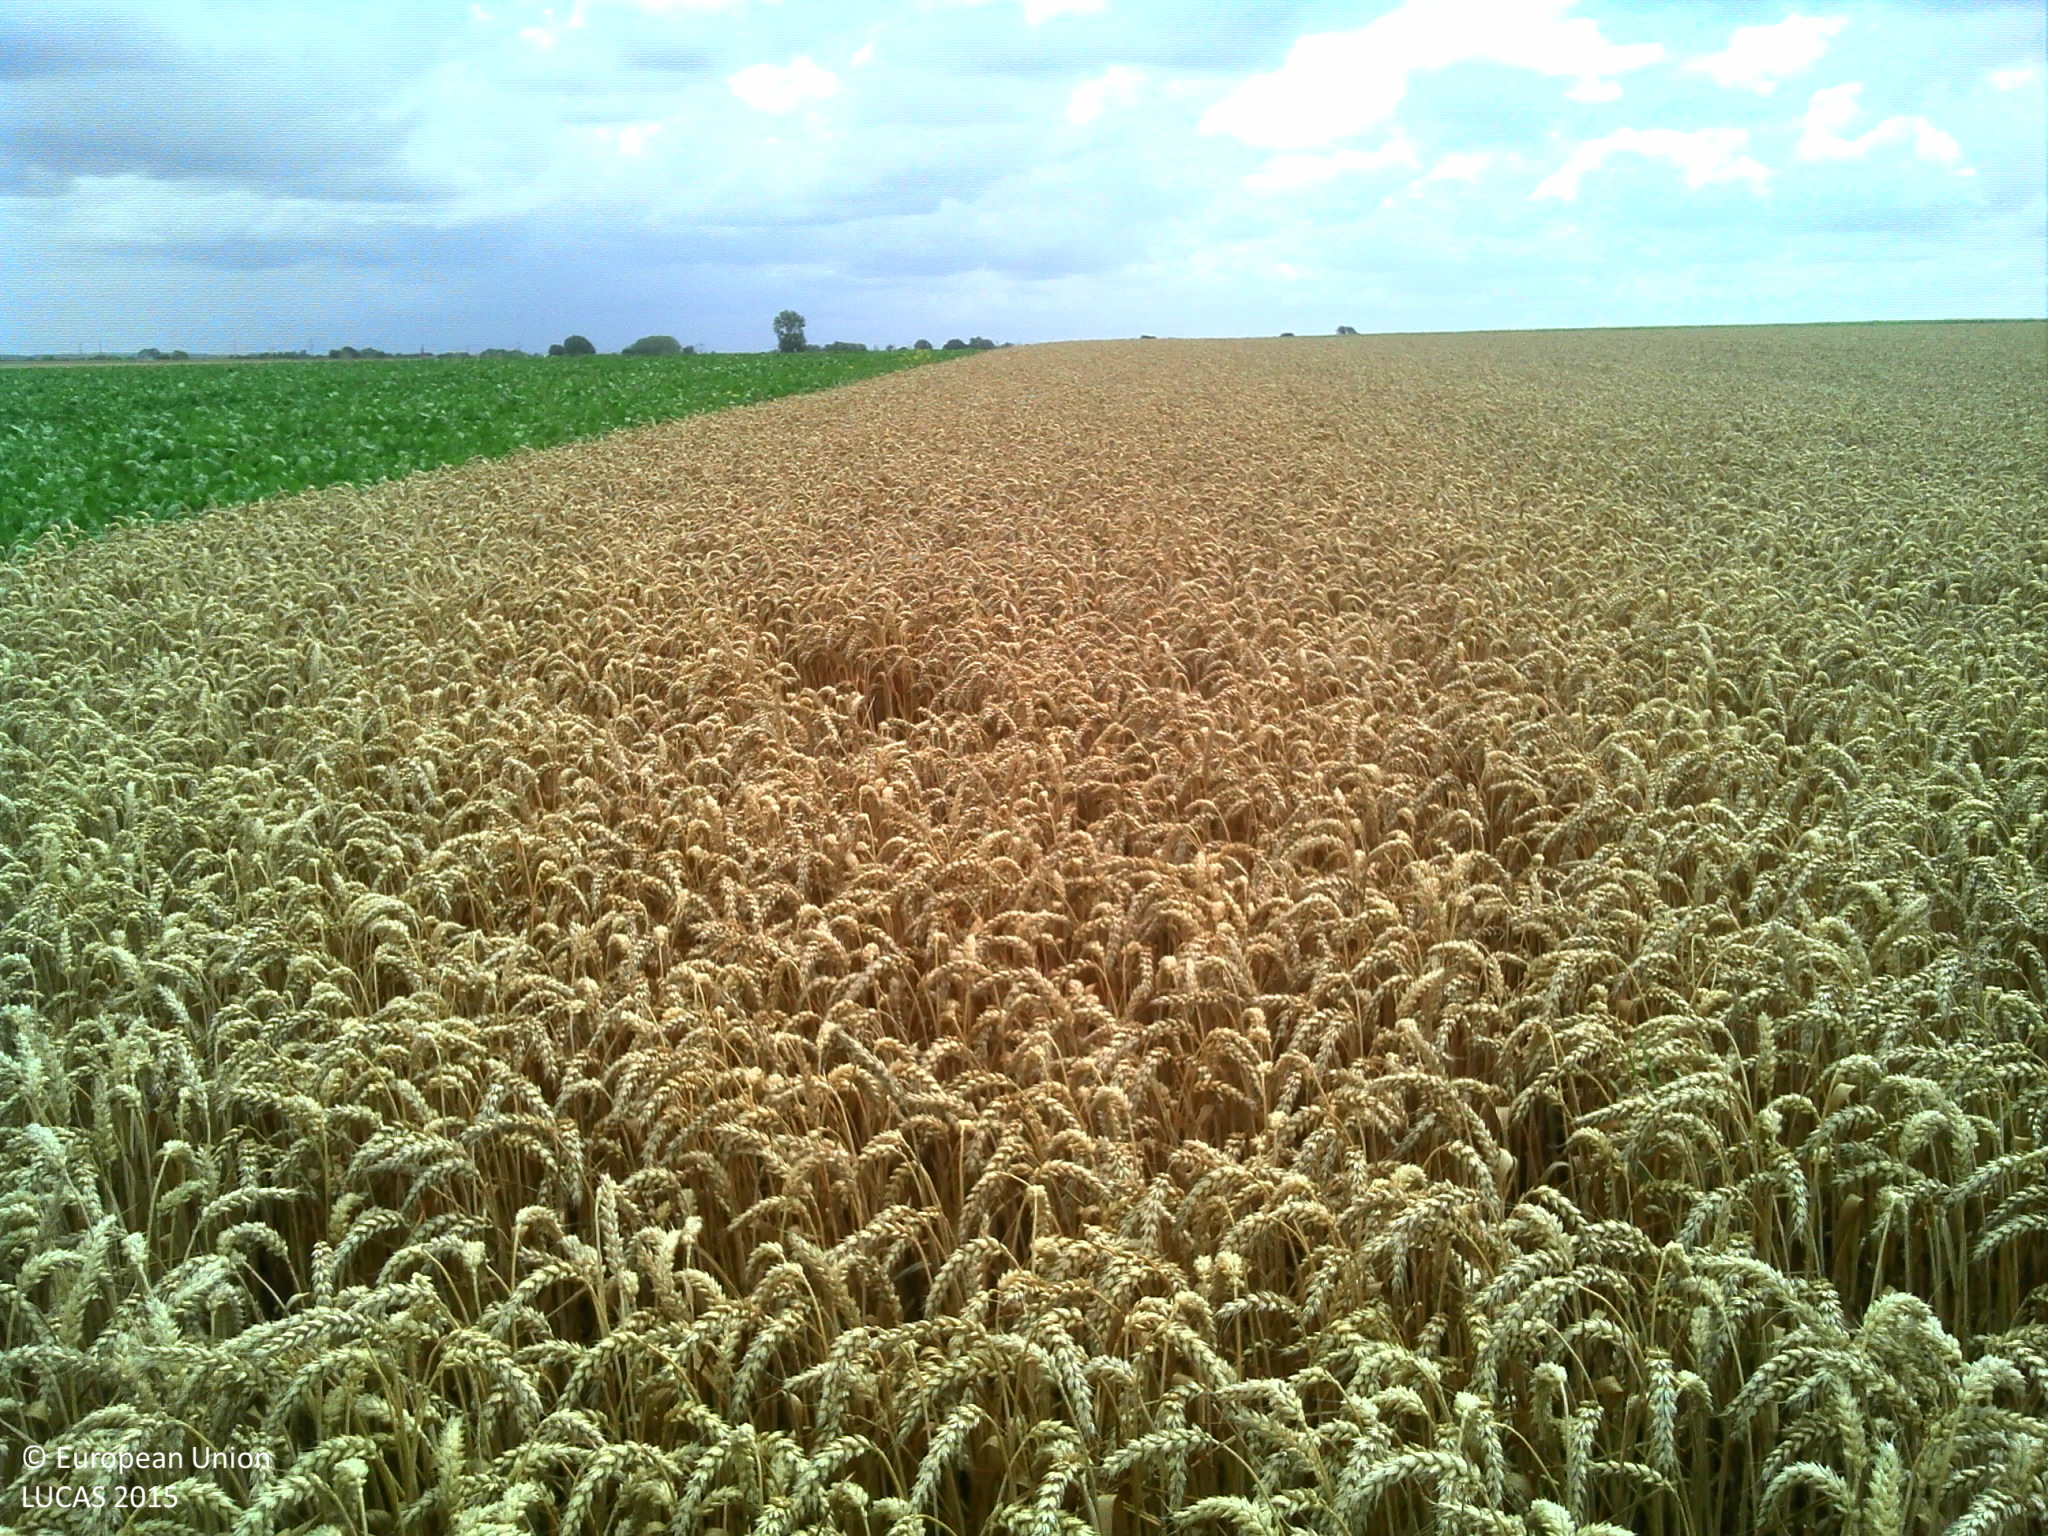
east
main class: Cropland
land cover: Common wheat
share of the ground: > 75 %
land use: Agriculture (excluding fallow land and kitchen gardens)
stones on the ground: < 10 %
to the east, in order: Common wheat; Sugar beet
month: July
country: FR
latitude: 49.9711
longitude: 3.6492
